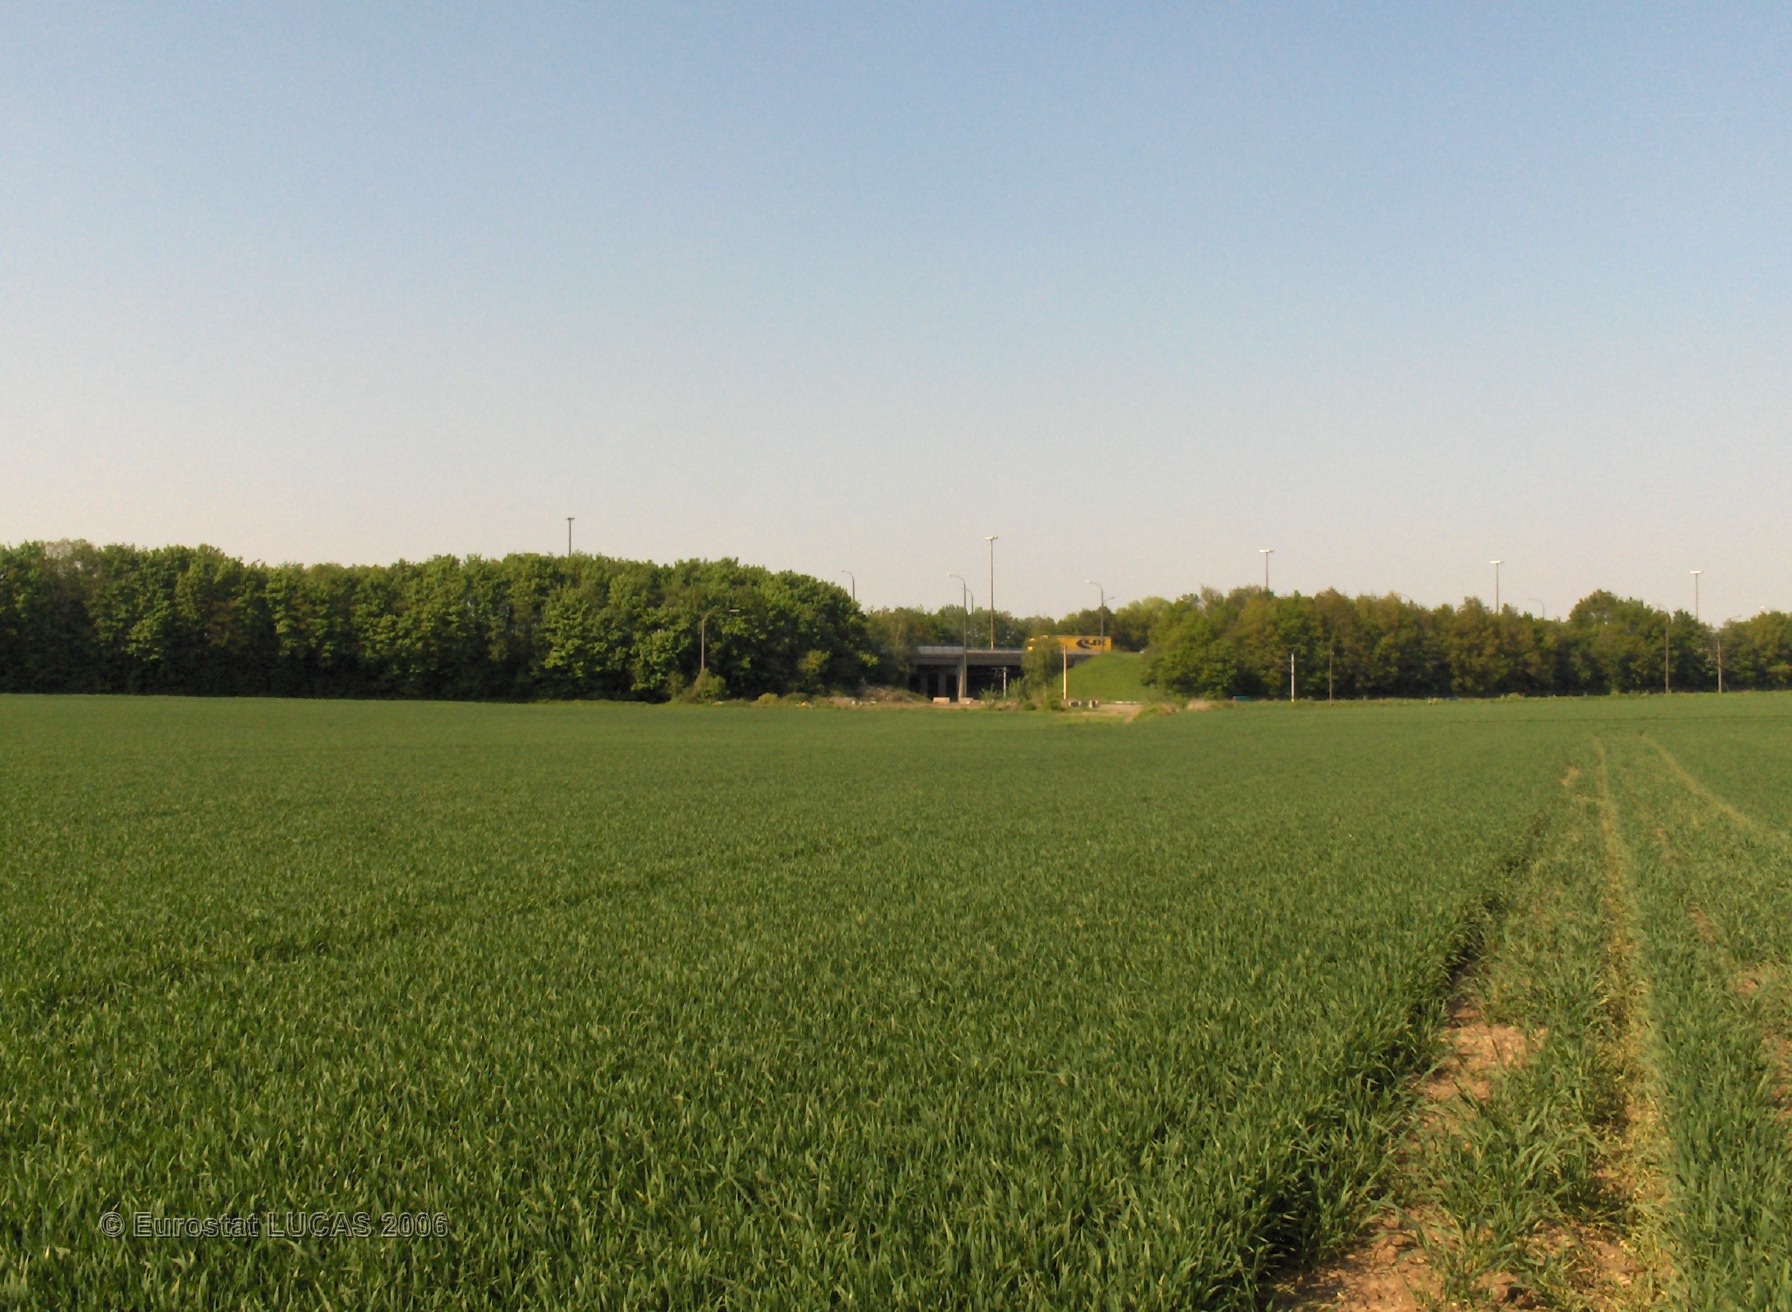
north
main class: Cropland
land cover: Common wheat
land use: Agriculture (excluding fallow land and kitchen gardens)
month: May
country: BE
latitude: 50.4682
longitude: 4.5436
